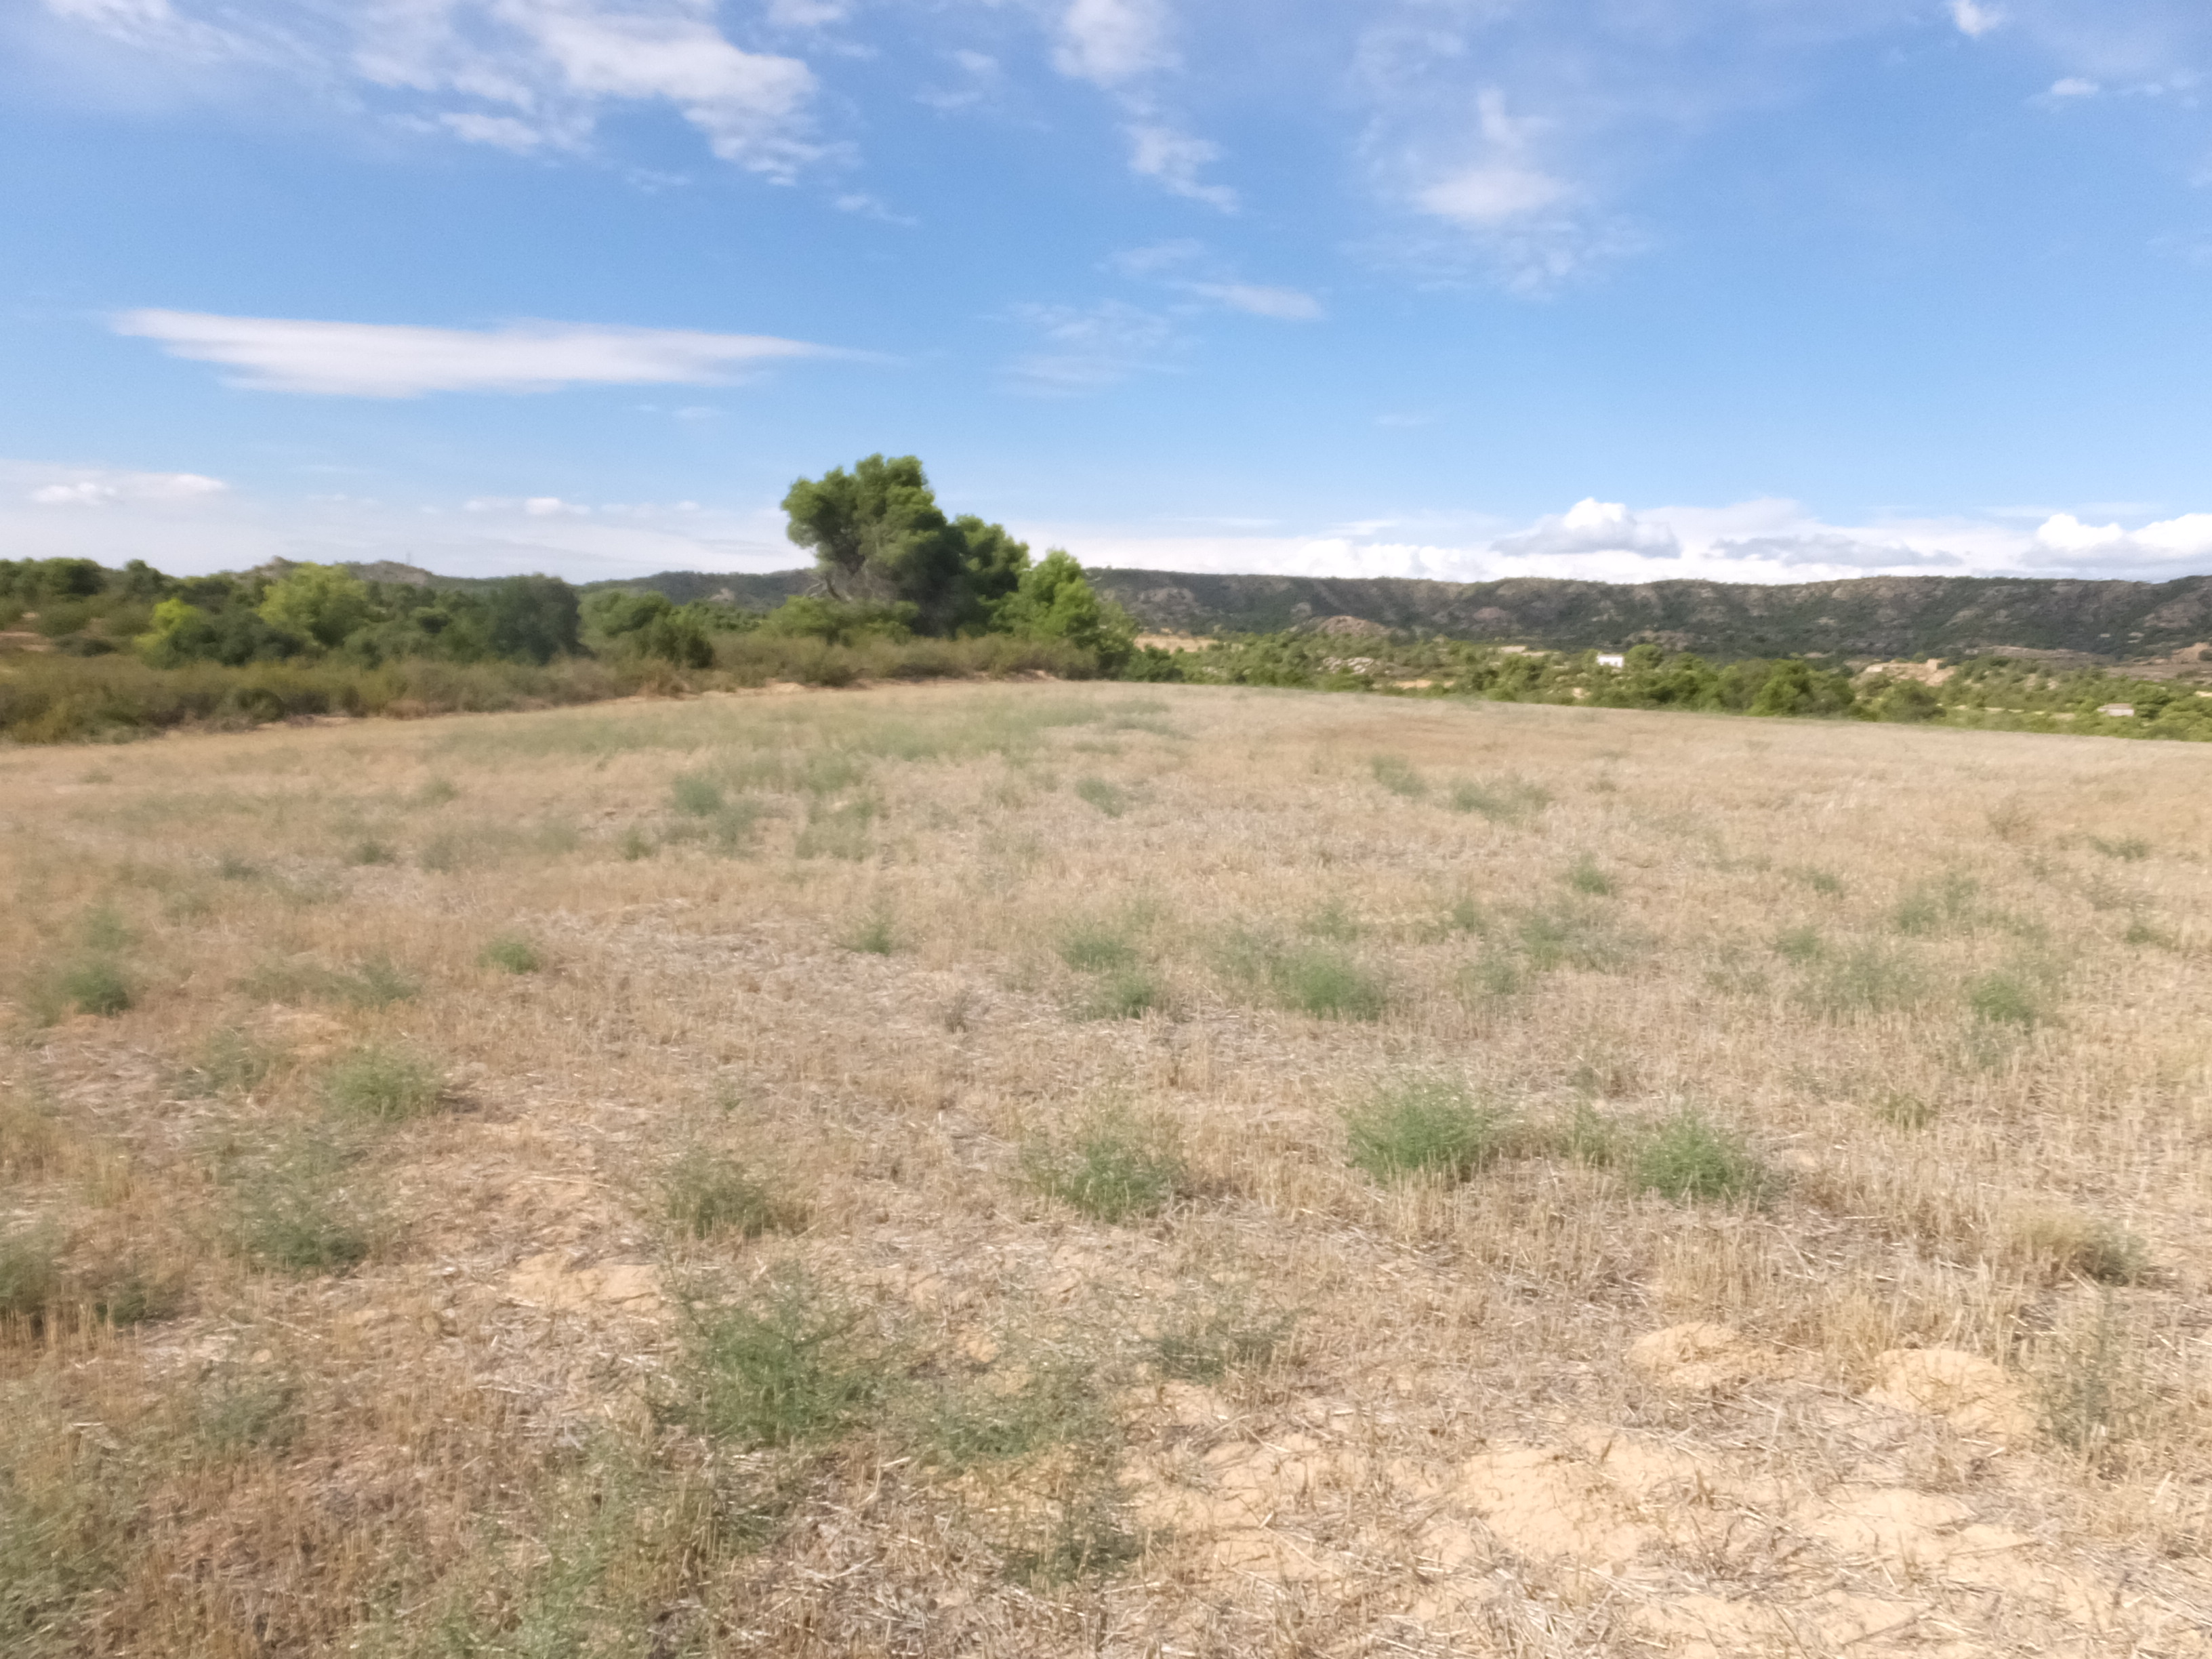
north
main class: Cropland
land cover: Barley
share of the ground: < 10 %
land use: Agriculture (excluding fallow land and kitchen gardens)
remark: Harvested field
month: August
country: ES
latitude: 41.2874
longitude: 0.2091
